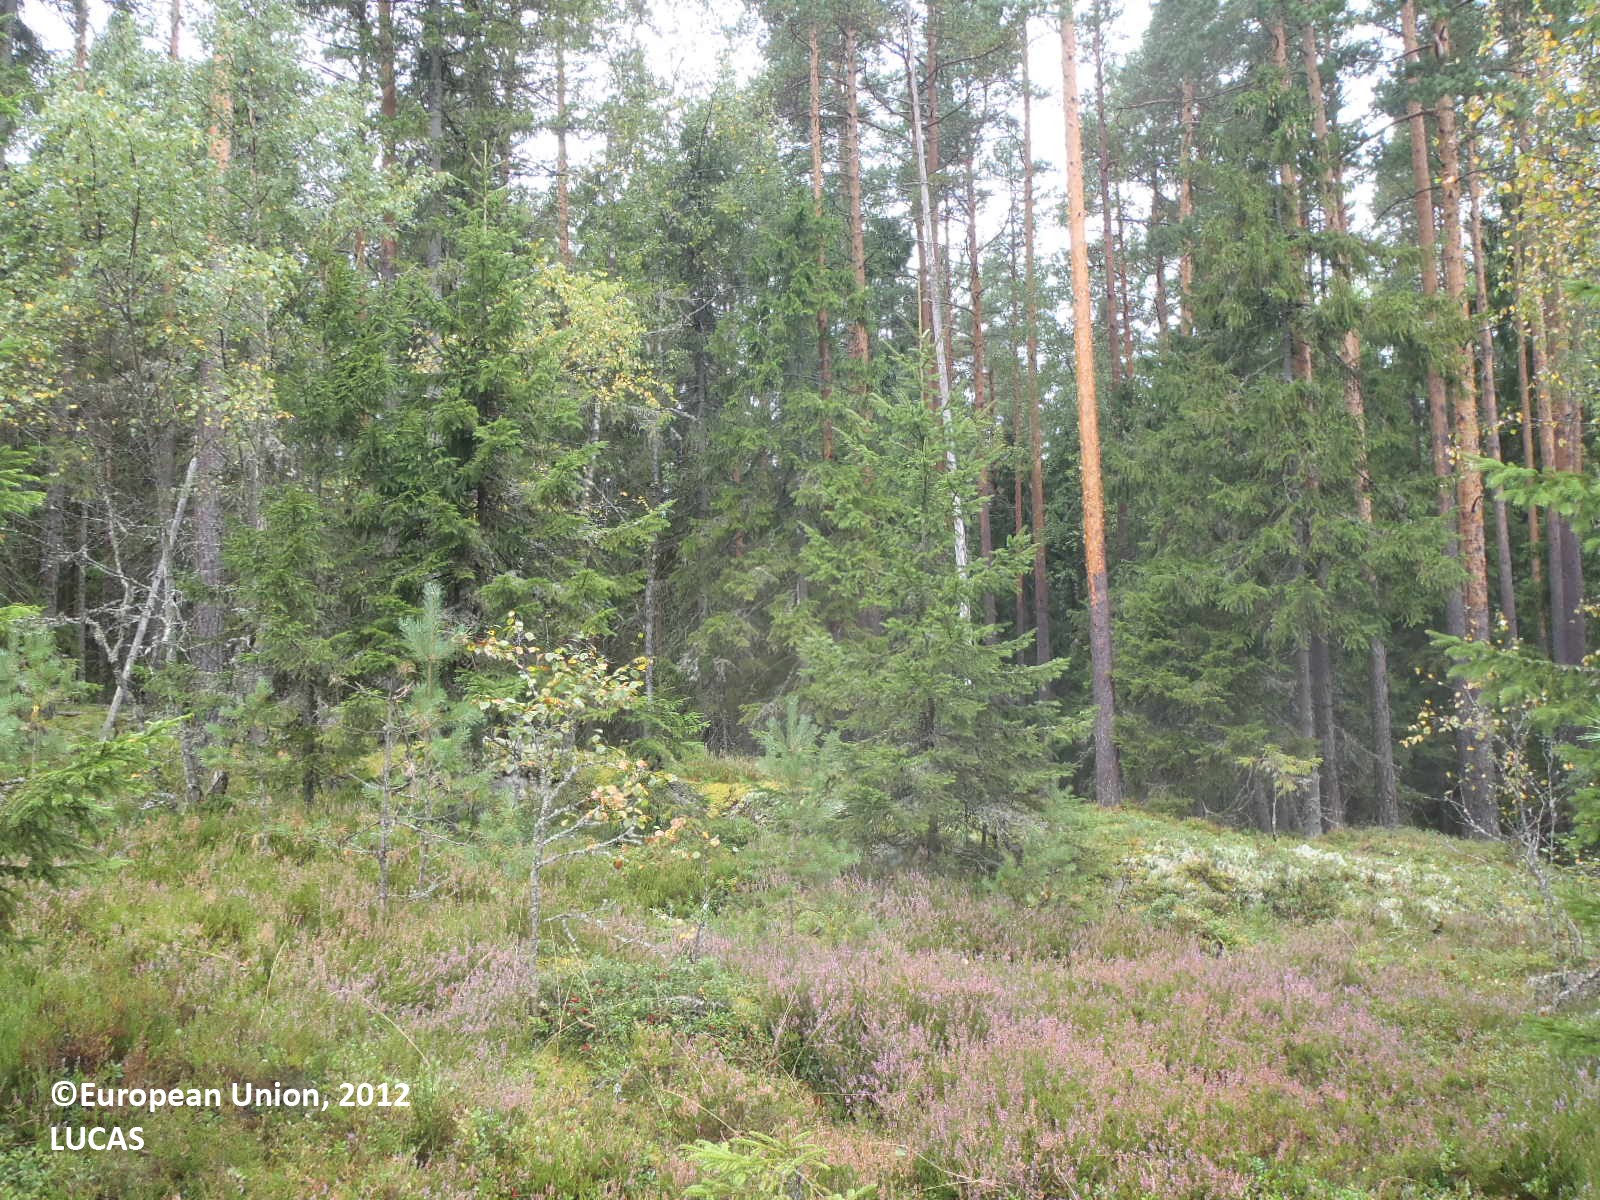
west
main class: Woodland
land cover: Other mixed woodland
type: boreal forest
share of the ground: 50 - 75 %
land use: Forestry
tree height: > 5 m
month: September
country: FI
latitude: 60.7327
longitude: 22.7433
